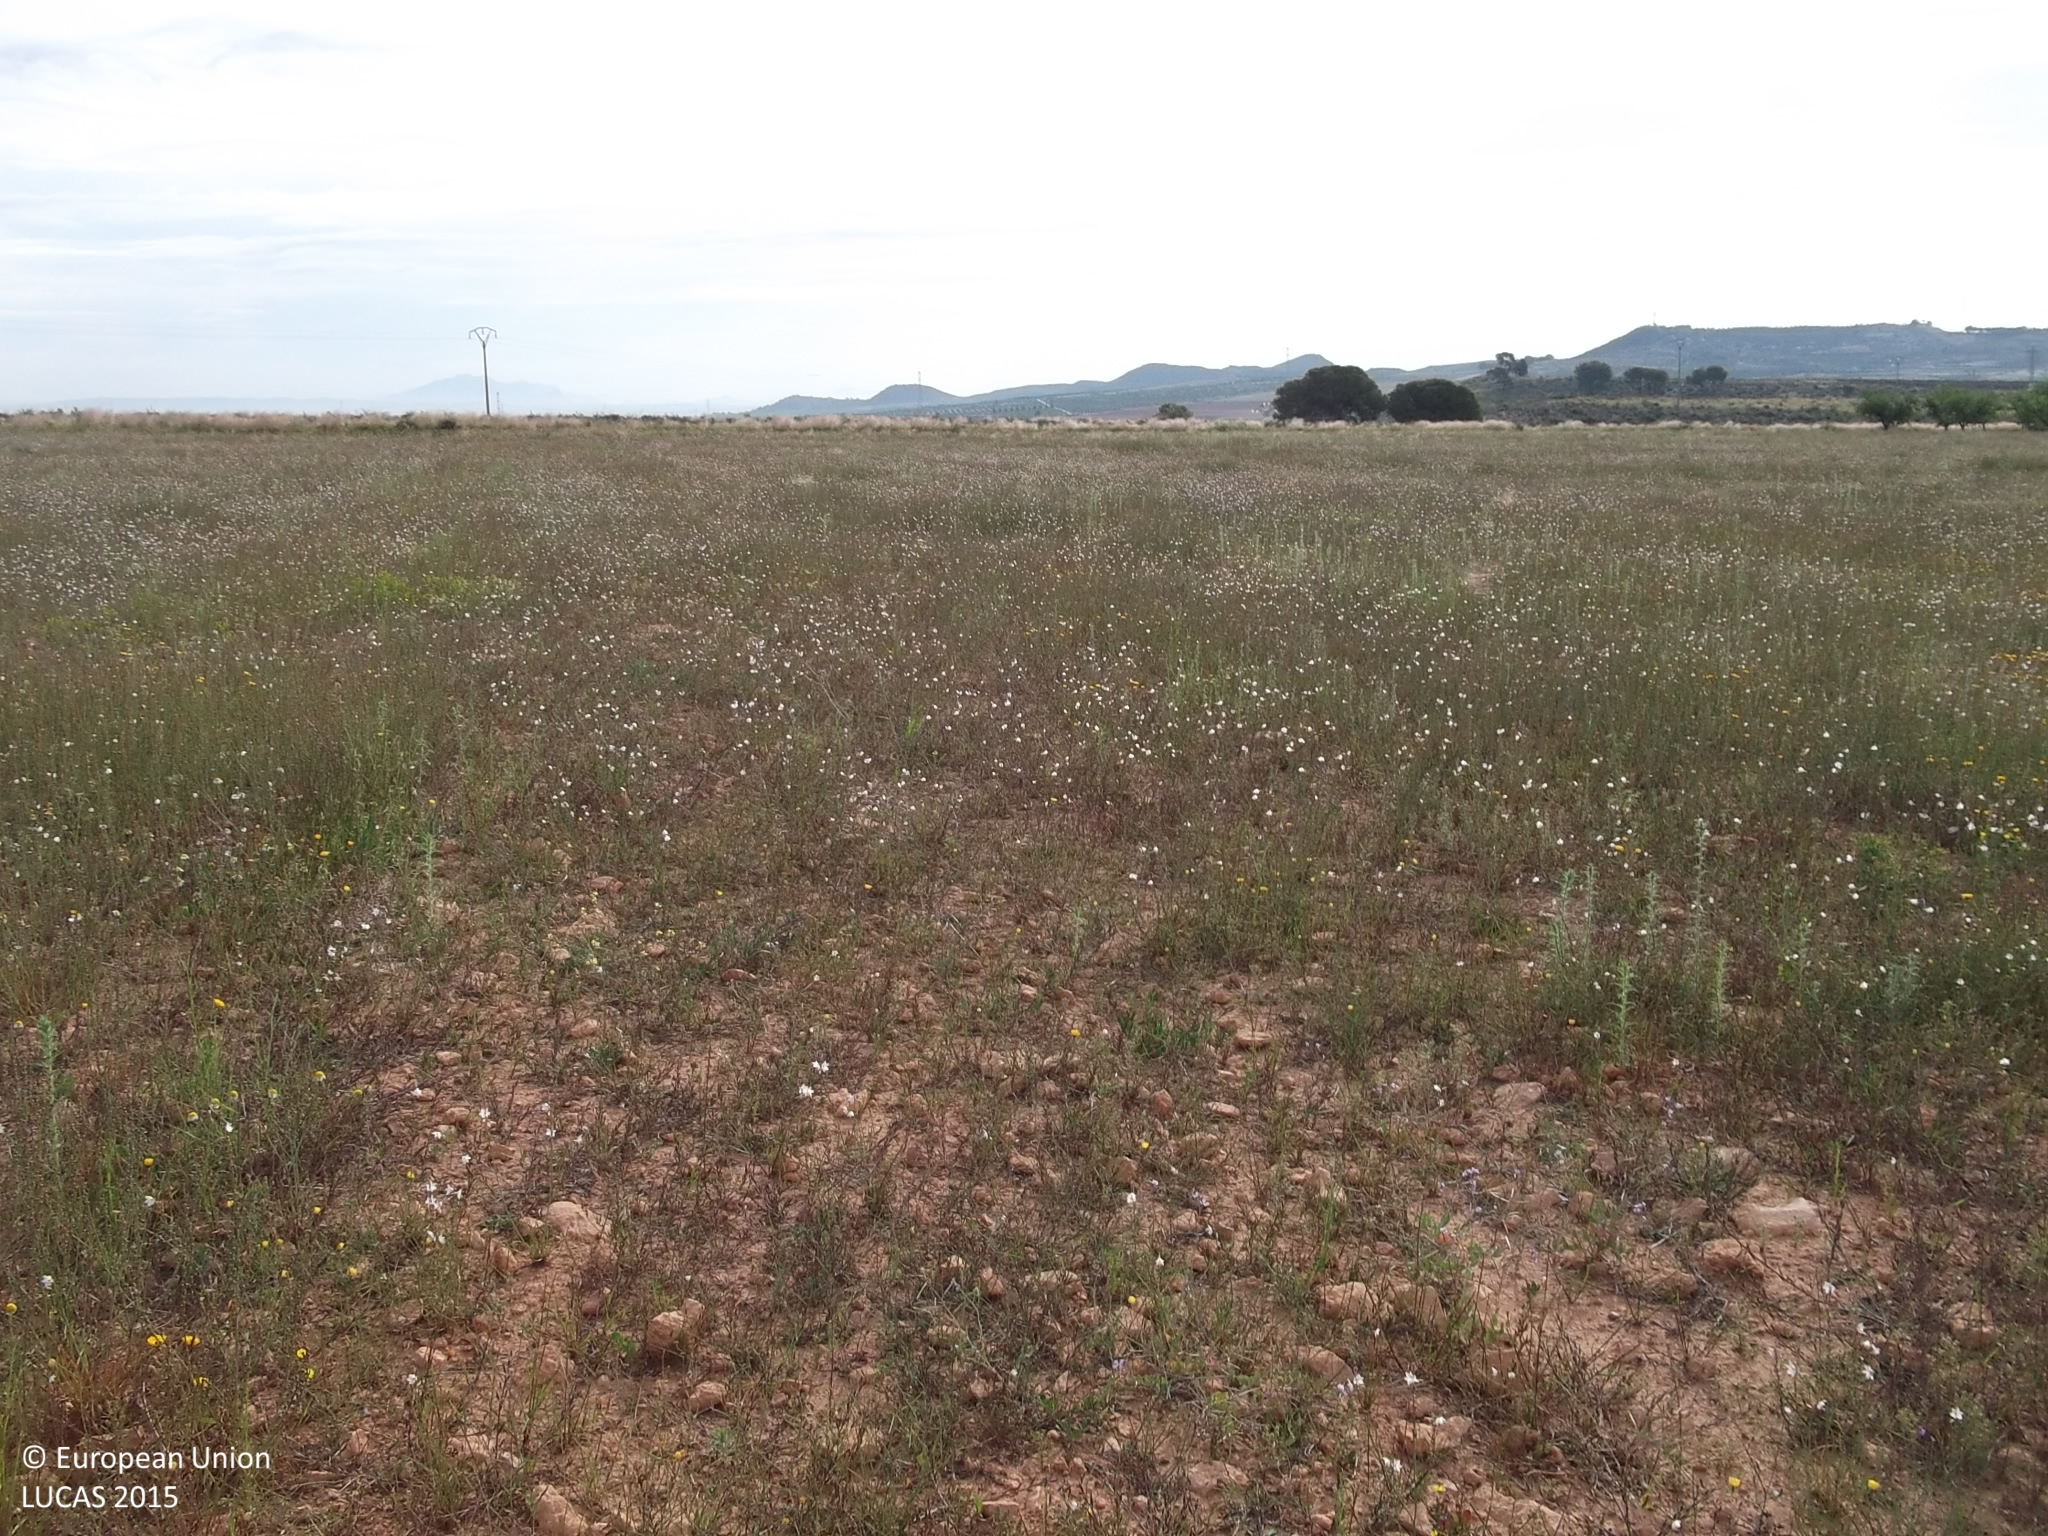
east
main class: Grassland
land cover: Spontaneously vegetated surfaces
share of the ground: 50 - 75 %
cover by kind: herbaceous plants 75 %, unconsolidated bare surface 25 %
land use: Fallow land
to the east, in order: Spontaneously vegetated surfaces; Grass margins; Paved roads, cycling and walking lanes; Grass margins; Spontaneously vegetated surfaces; Shrubland without tree cover; Single bushes/trees; Shrubland without tree cover
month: April
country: ES
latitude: 37.9534
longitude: -1.4225
